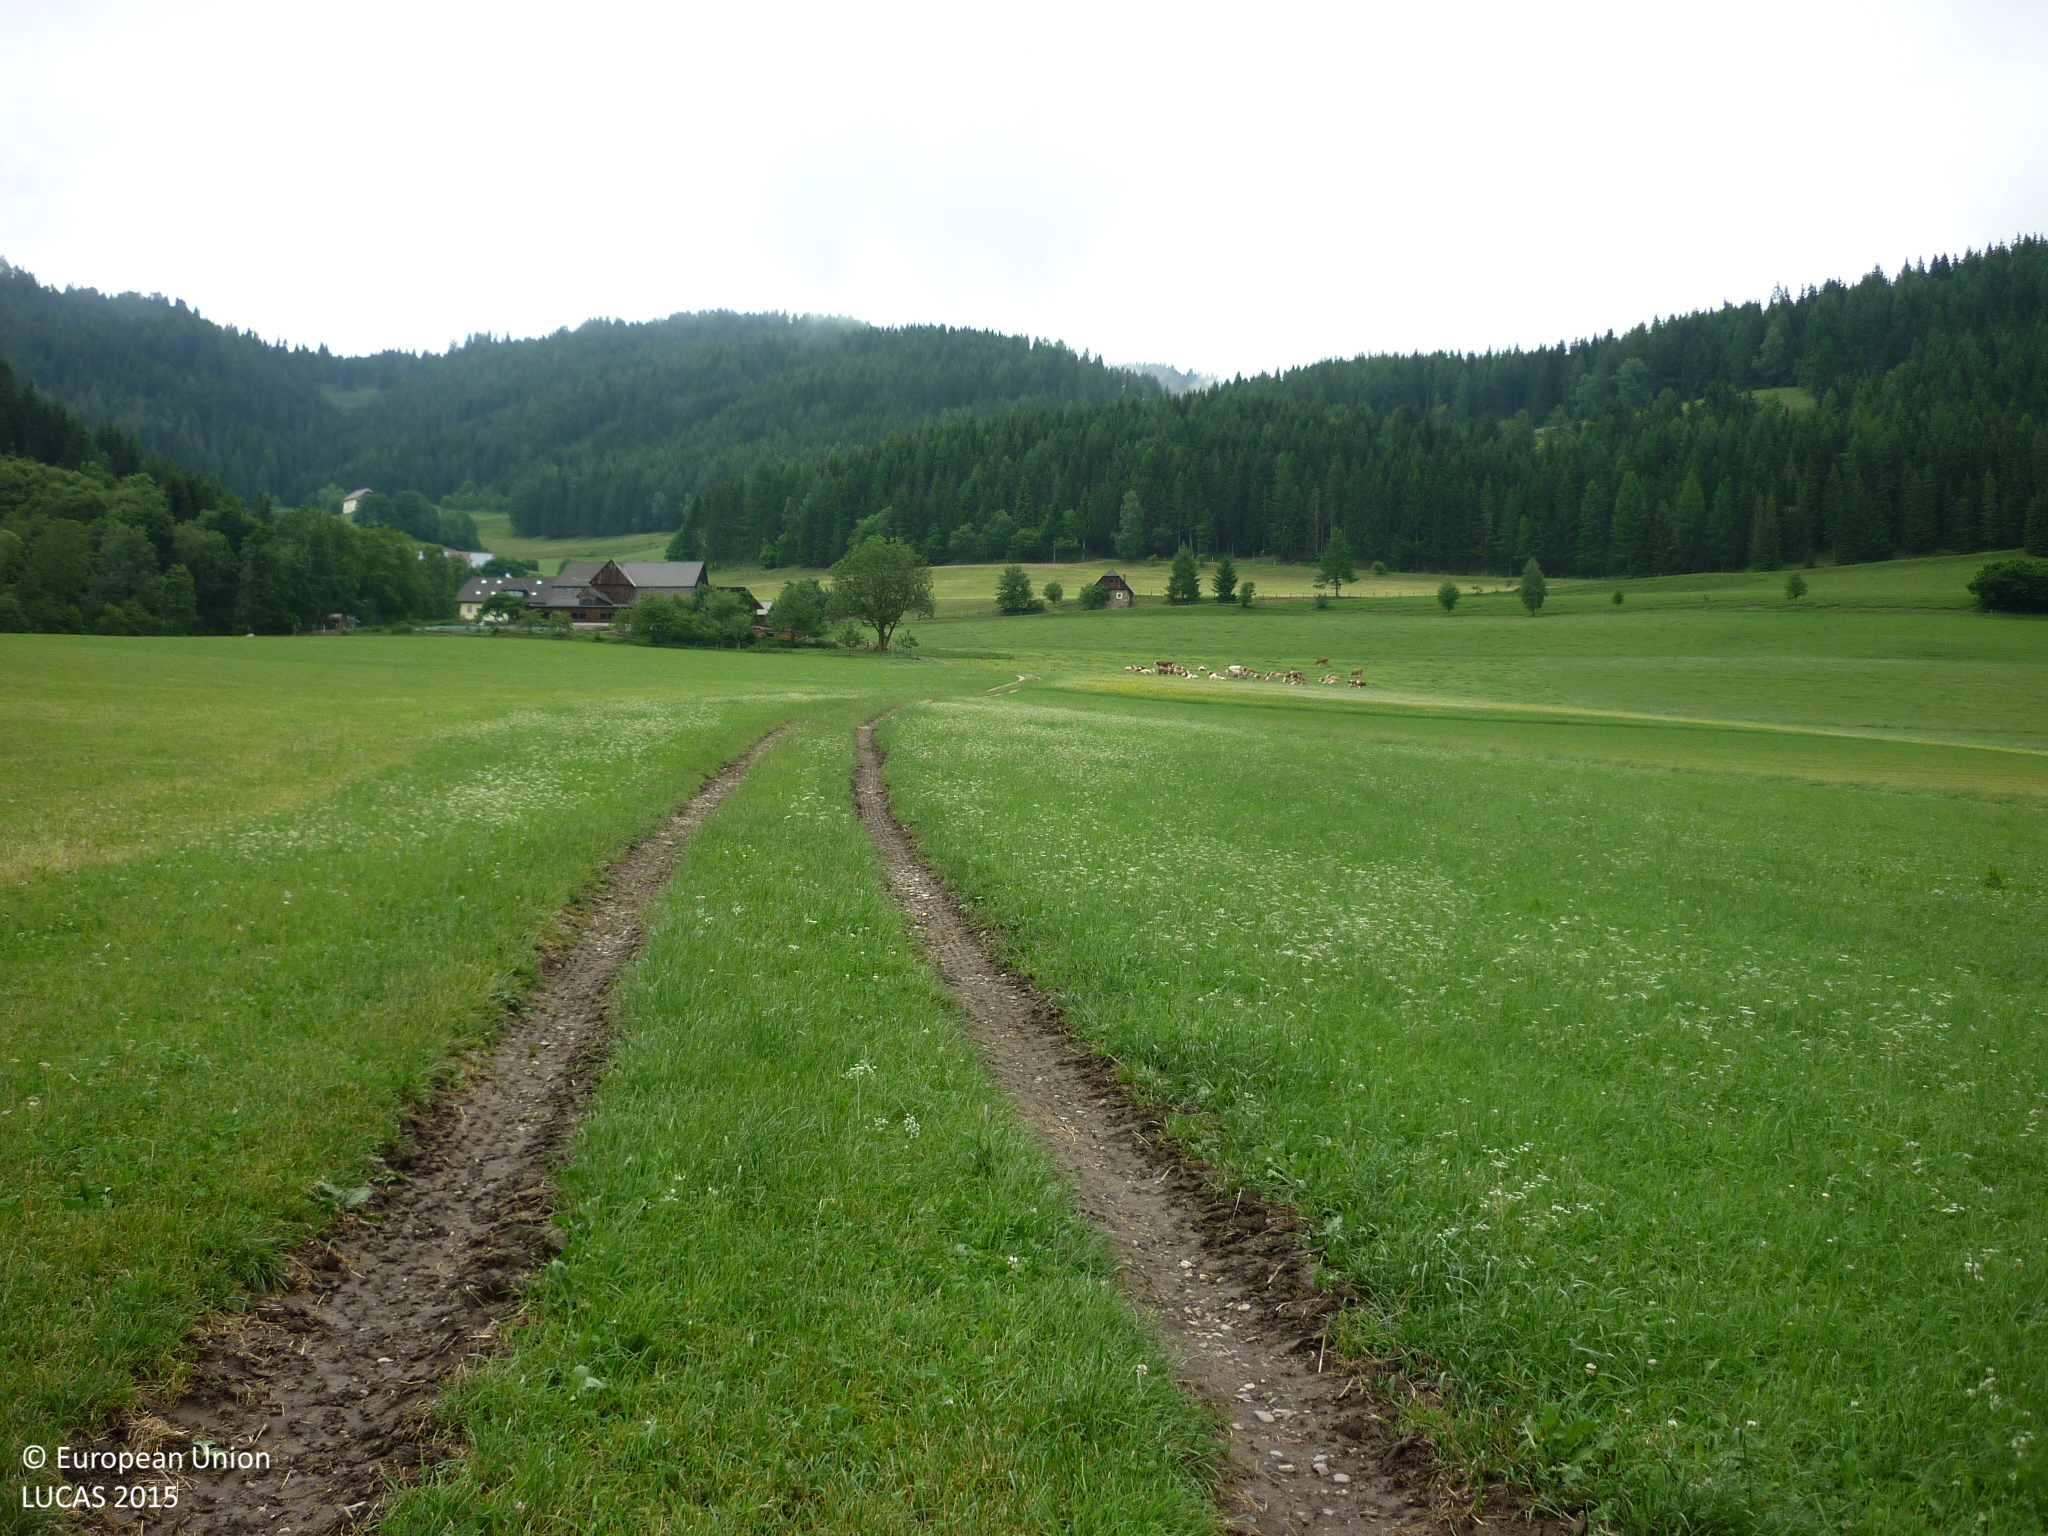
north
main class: Grassland
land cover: Grassland without tree/shrub cover
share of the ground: > 75 %
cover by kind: herbaceous plants 100 %
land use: Agriculture (excluding fallow land and kitchen gardens)
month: June
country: AT
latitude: 47.0940
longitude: 14.3063
